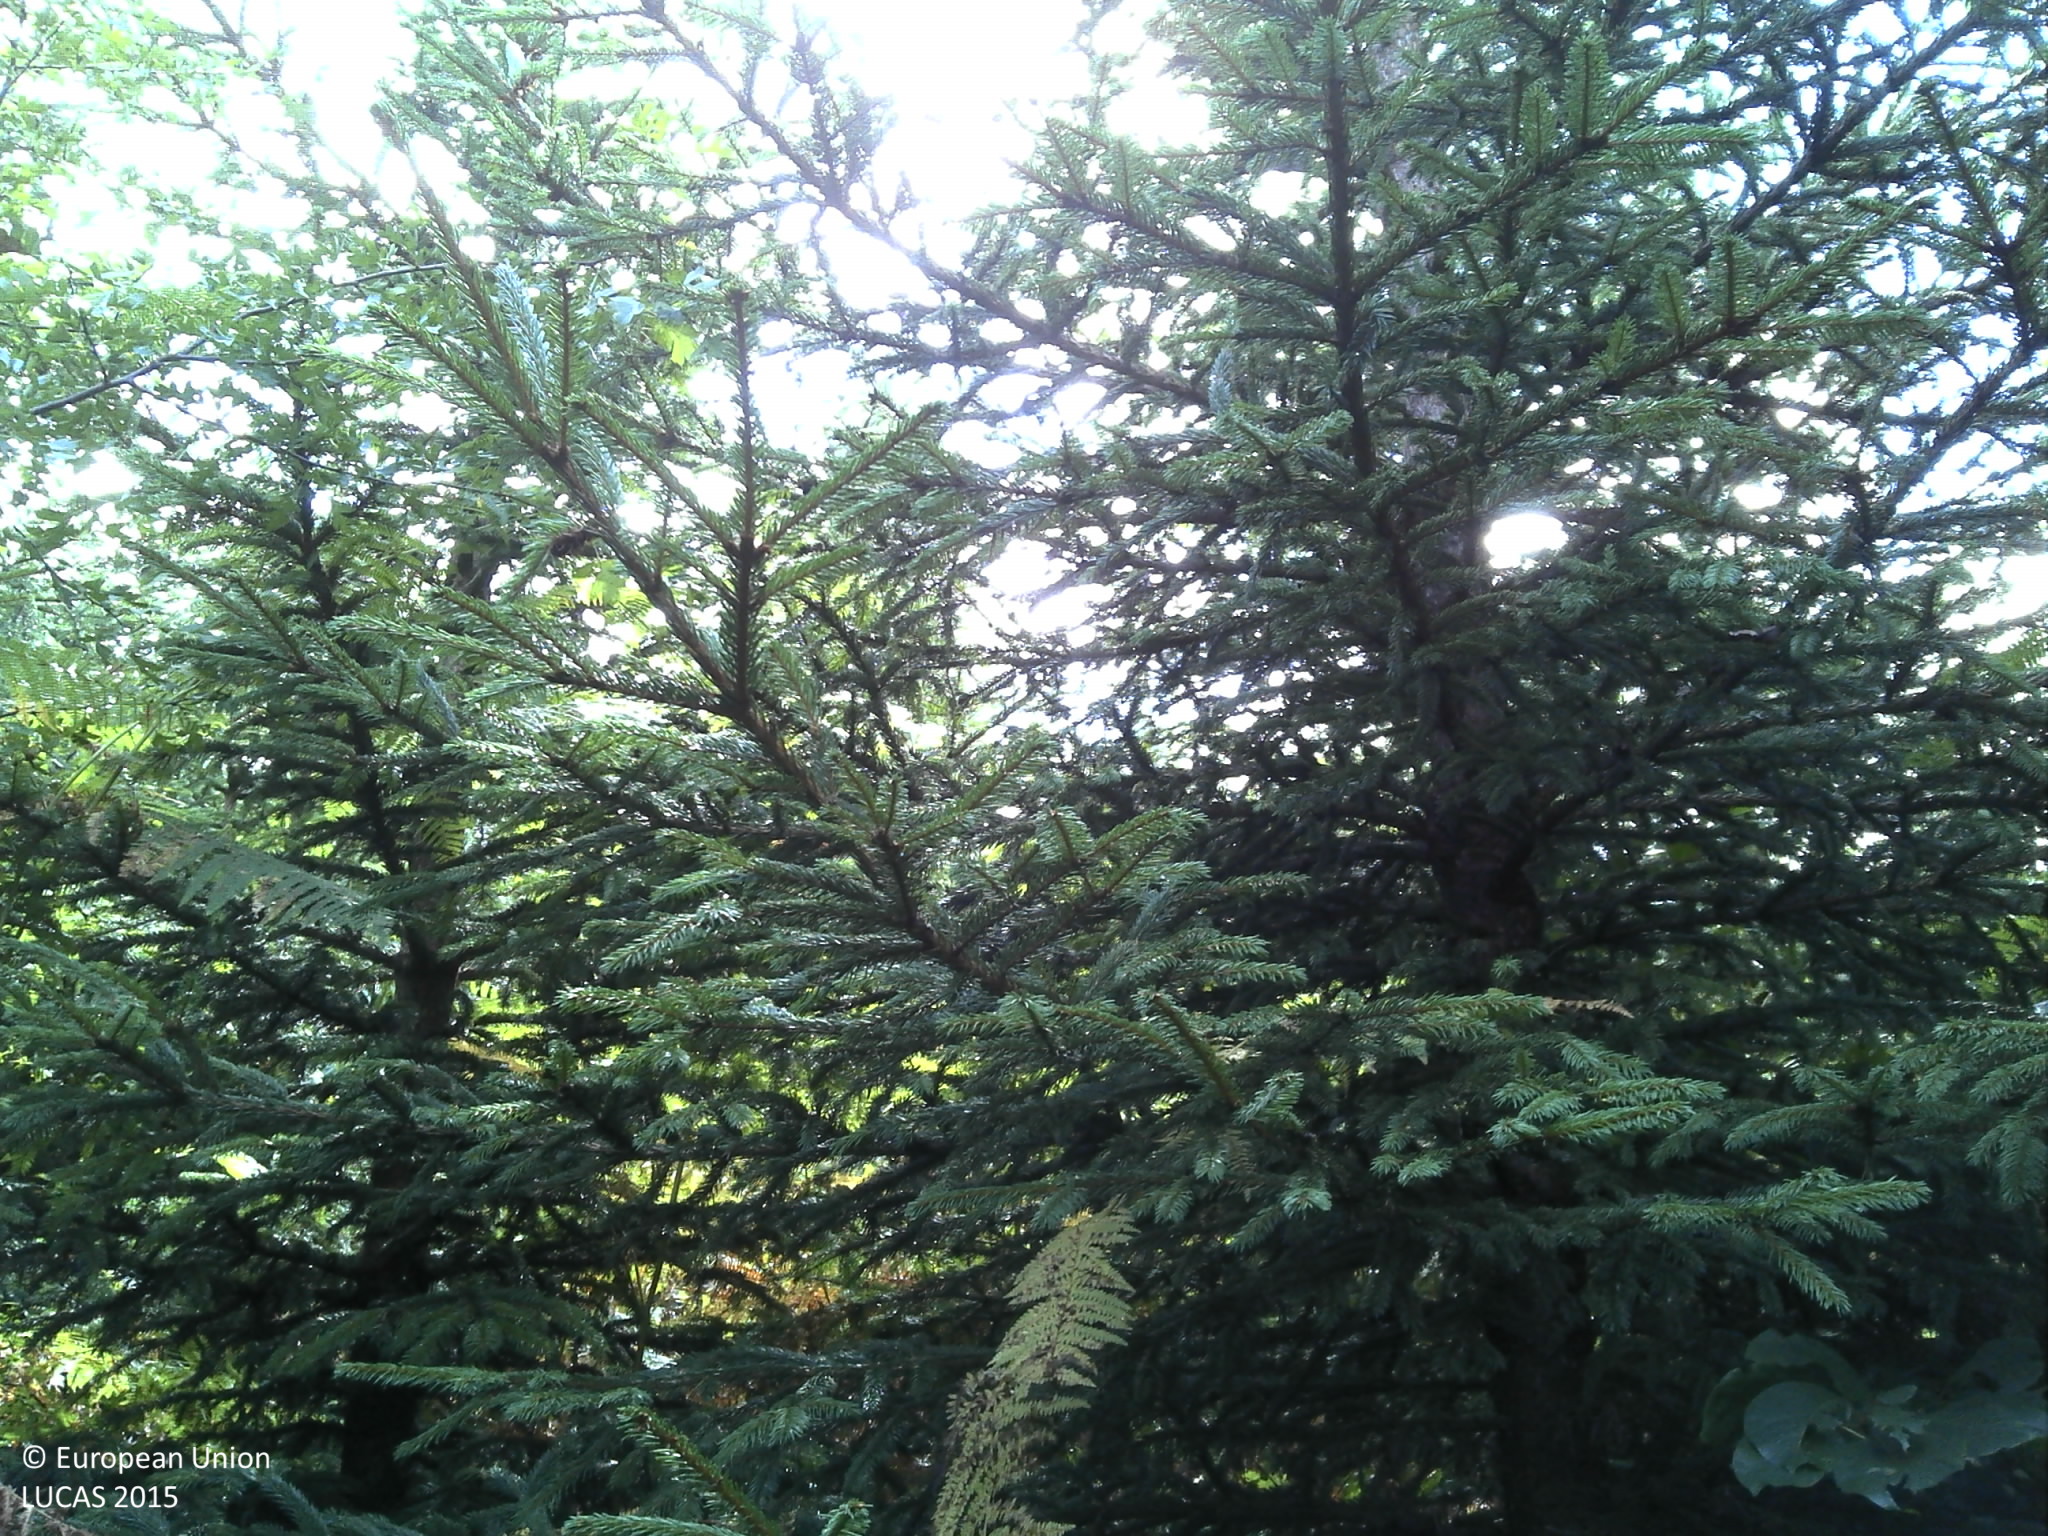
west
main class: Woodland
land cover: Spruce dominated coniferous woodland
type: coniferous forest of the mediterranean region
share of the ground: > 75 %
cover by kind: coniferous forest trees 100 %
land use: Forestry
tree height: > 5 m
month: September
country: HR
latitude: 45.2984
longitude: 15.3131
